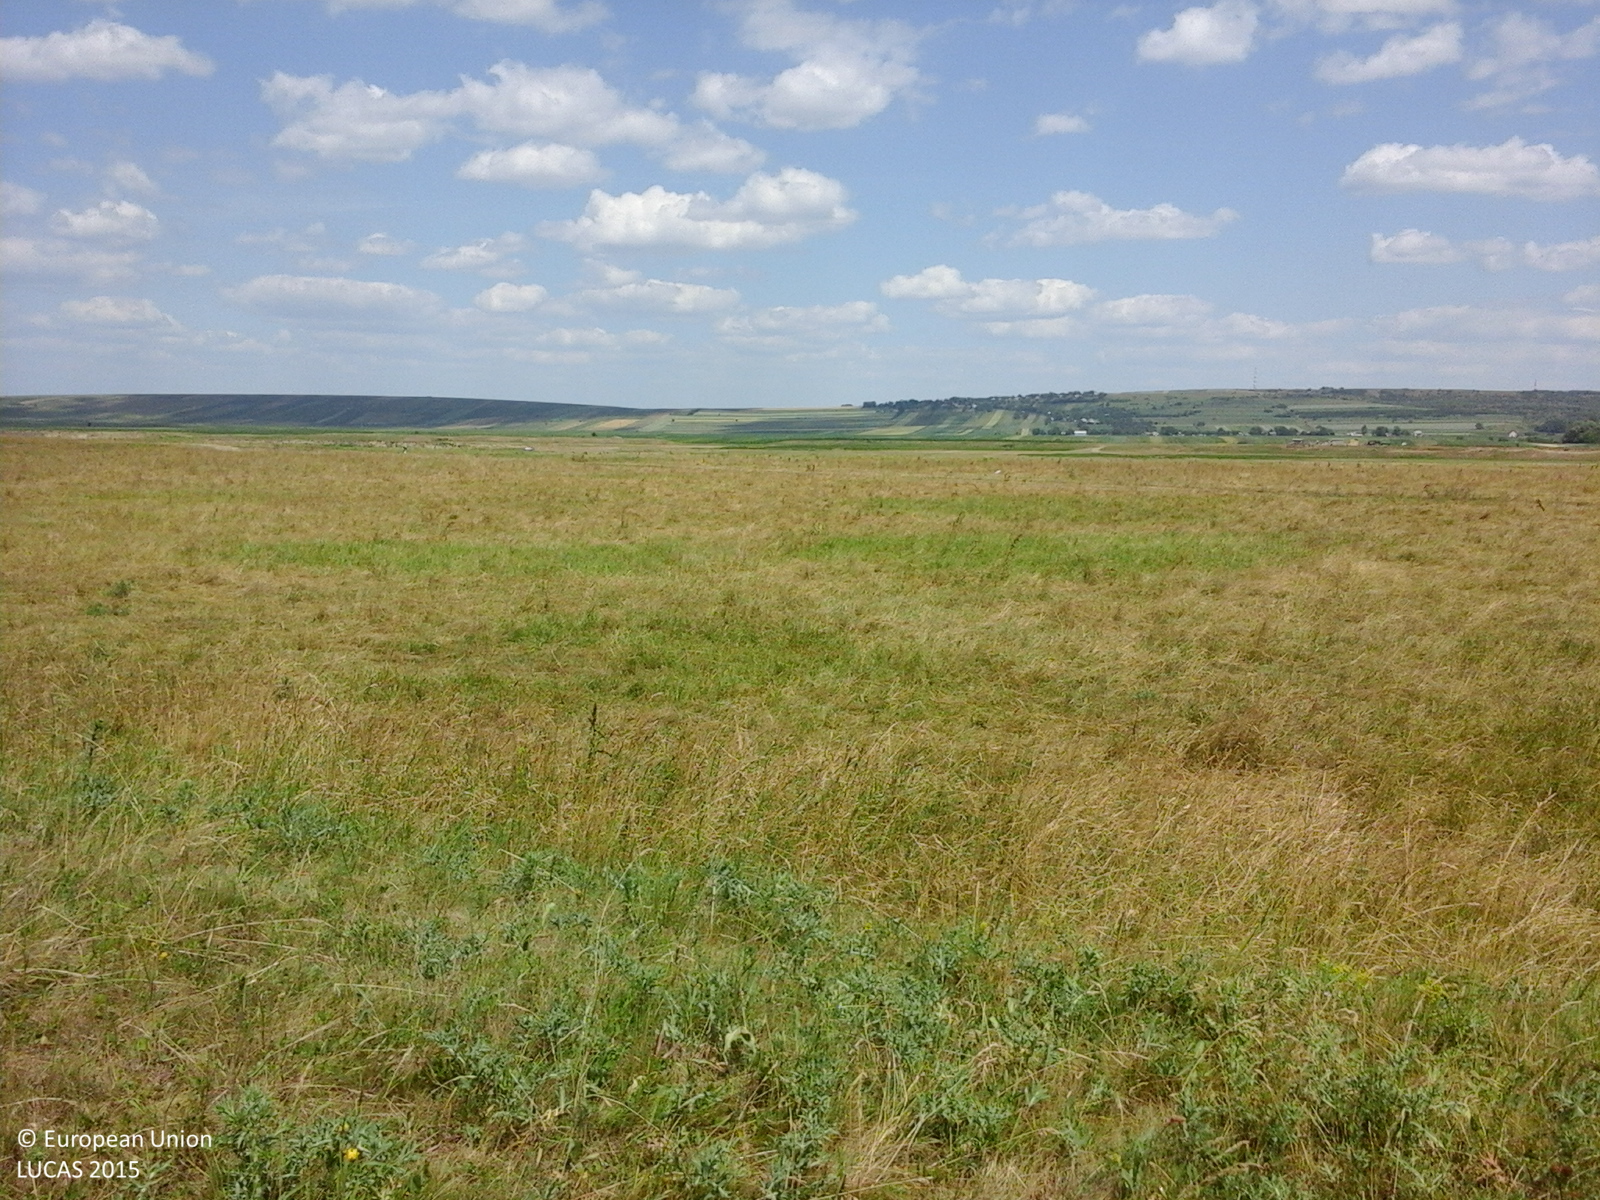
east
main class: Grassland
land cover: Grassland without tree/shrub cover
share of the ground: > 75 %
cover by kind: herbaceous plants 100 %
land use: Agriculture (excluding fallow land and kitchen gardens)
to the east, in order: Grassland without tree/shrub cover; Tracks; Spontaneously vegetated surfaces
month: June
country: RO
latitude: 47.5871
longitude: 26.5391
